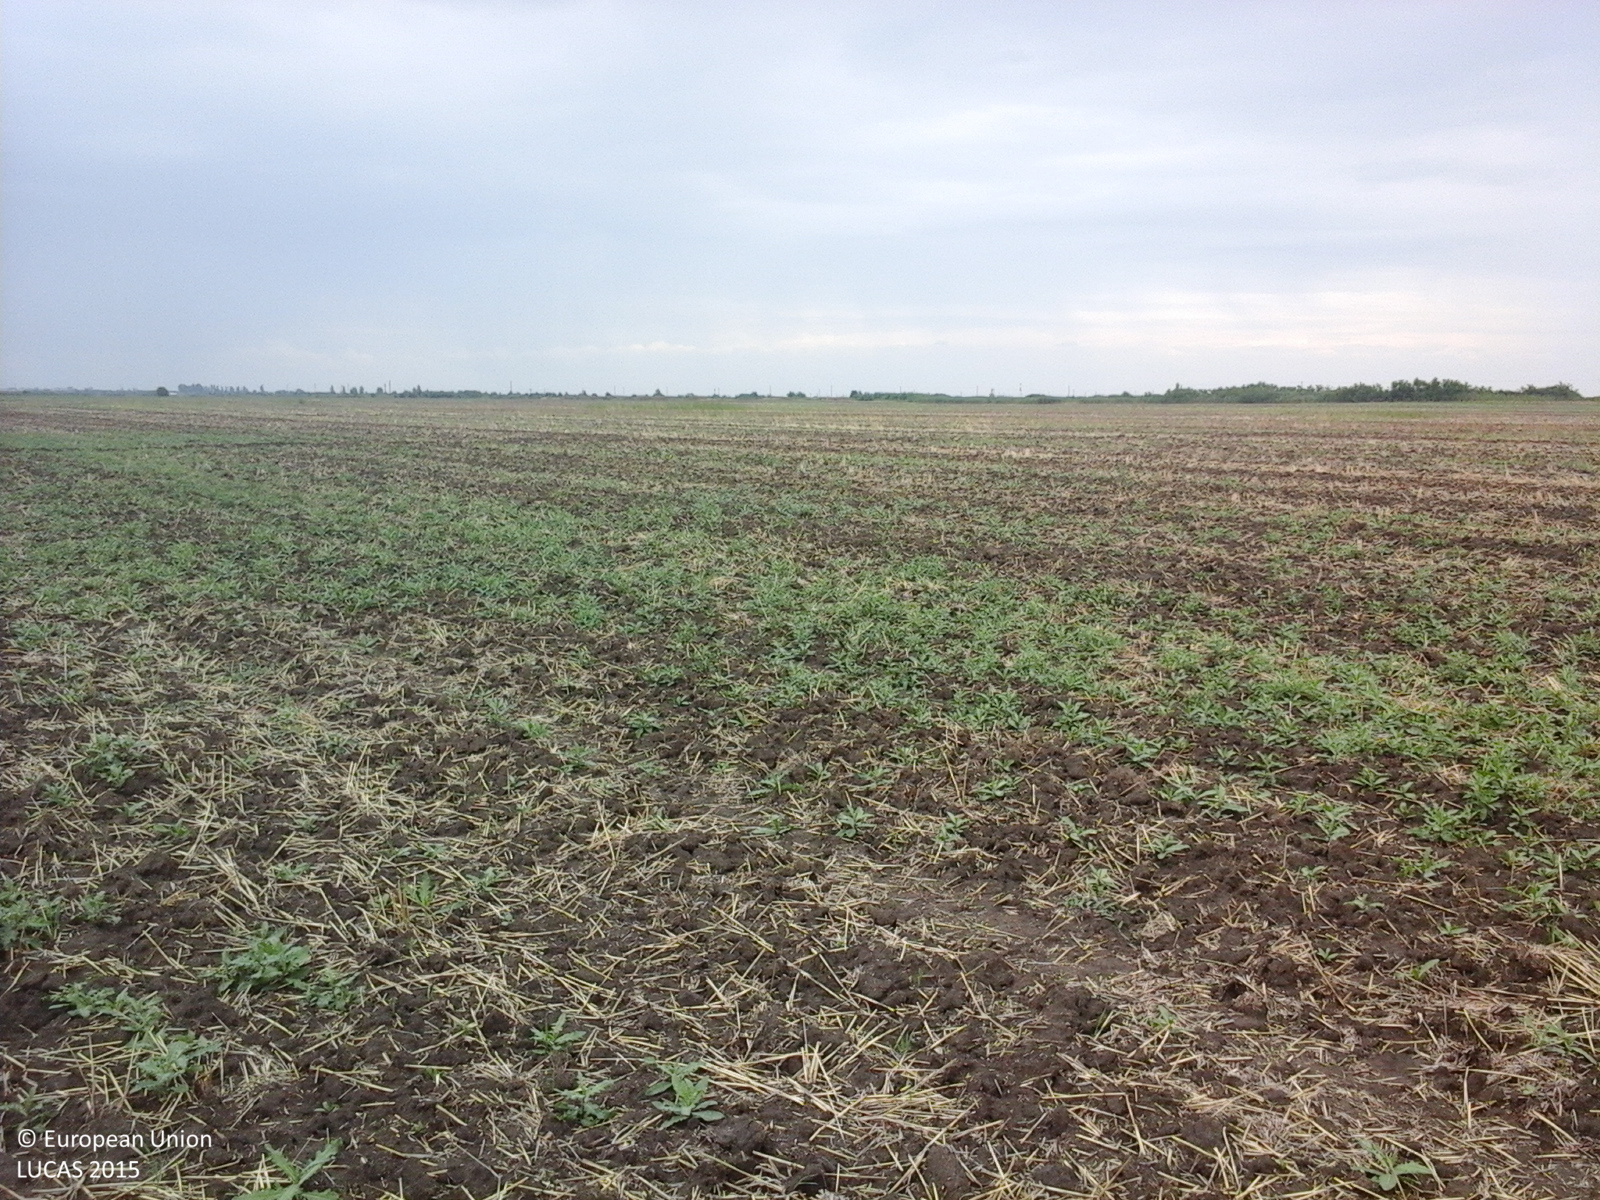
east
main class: Cropland
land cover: Common wheat
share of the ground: < 10 %
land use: Agriculture (excluding fallow land and kitchen gardens)
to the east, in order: Common wheat
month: August
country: RO
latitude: 46.0630
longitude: 20.5606
